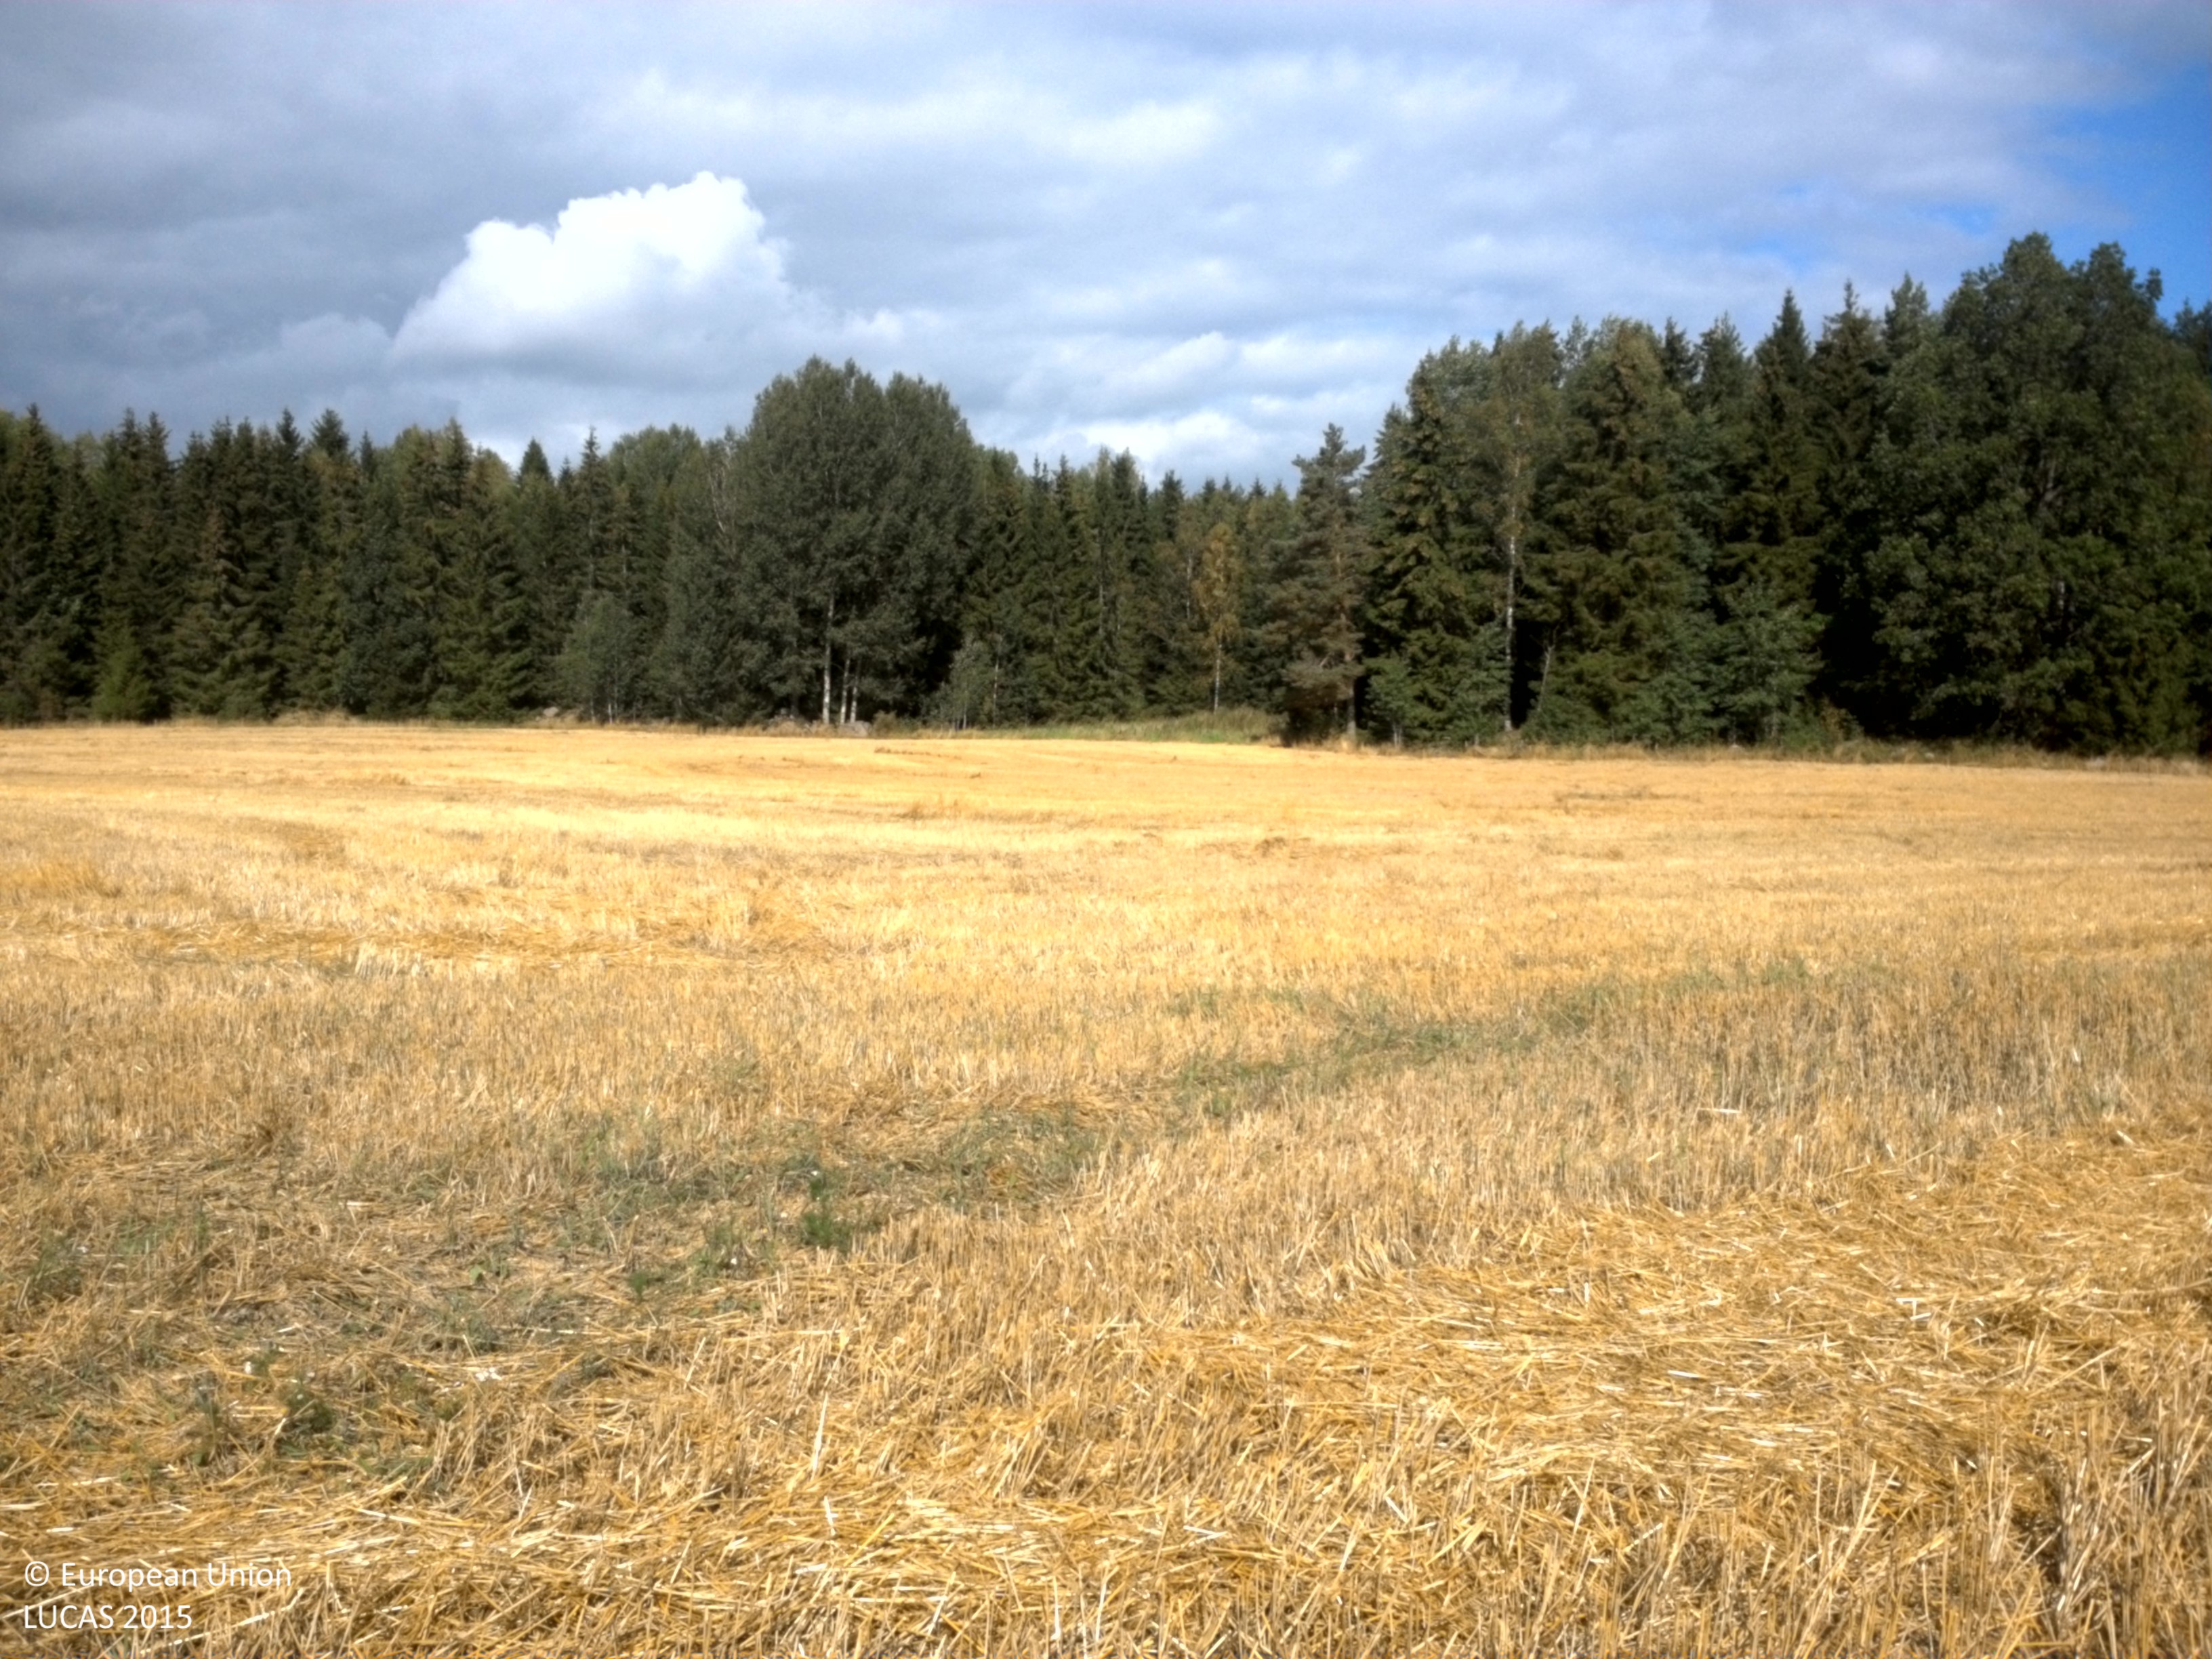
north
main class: Cropland
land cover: Common wheat
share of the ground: 10 - 25 %
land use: Agriculture (excluding fallow land and kitchen gardens)
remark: Harvested field
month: August
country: SE
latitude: 59.9476
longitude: 17.7818
